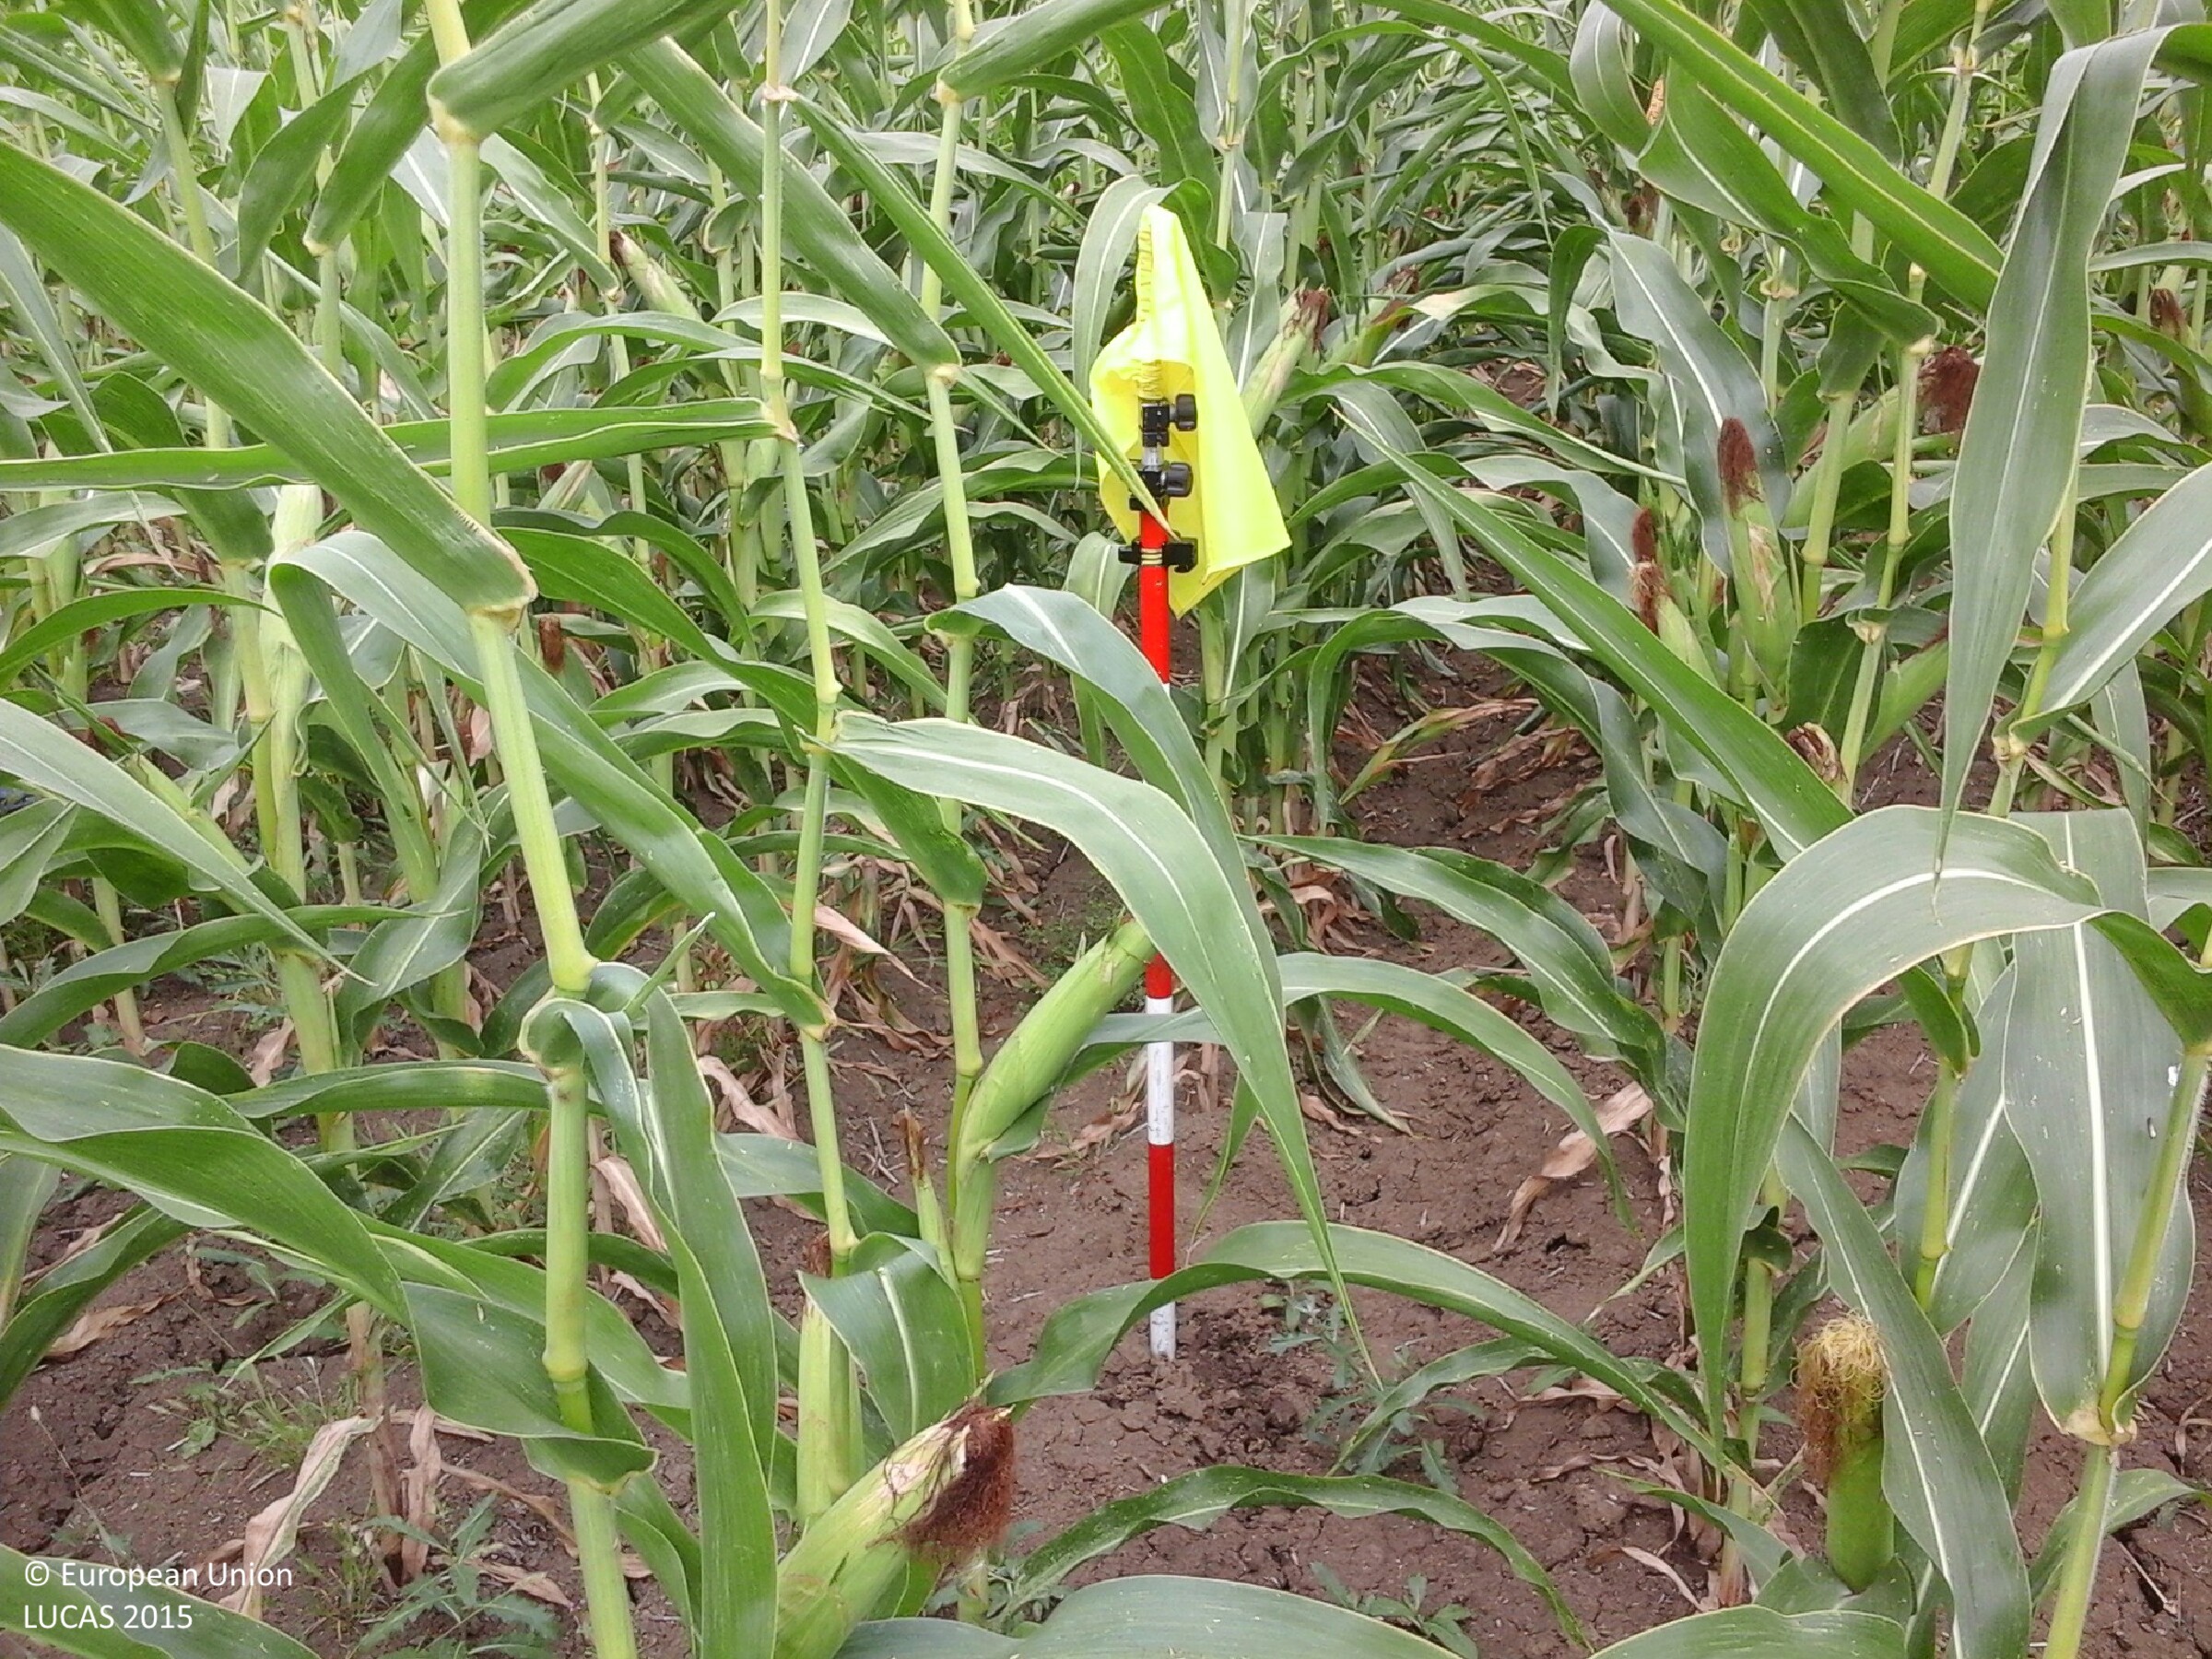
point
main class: Cropland
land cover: Maize
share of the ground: > 75 %
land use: Agriculture (excluding fallow land and kitchen gardens)
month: July
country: HU
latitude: 47.4922
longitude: 20.6110
